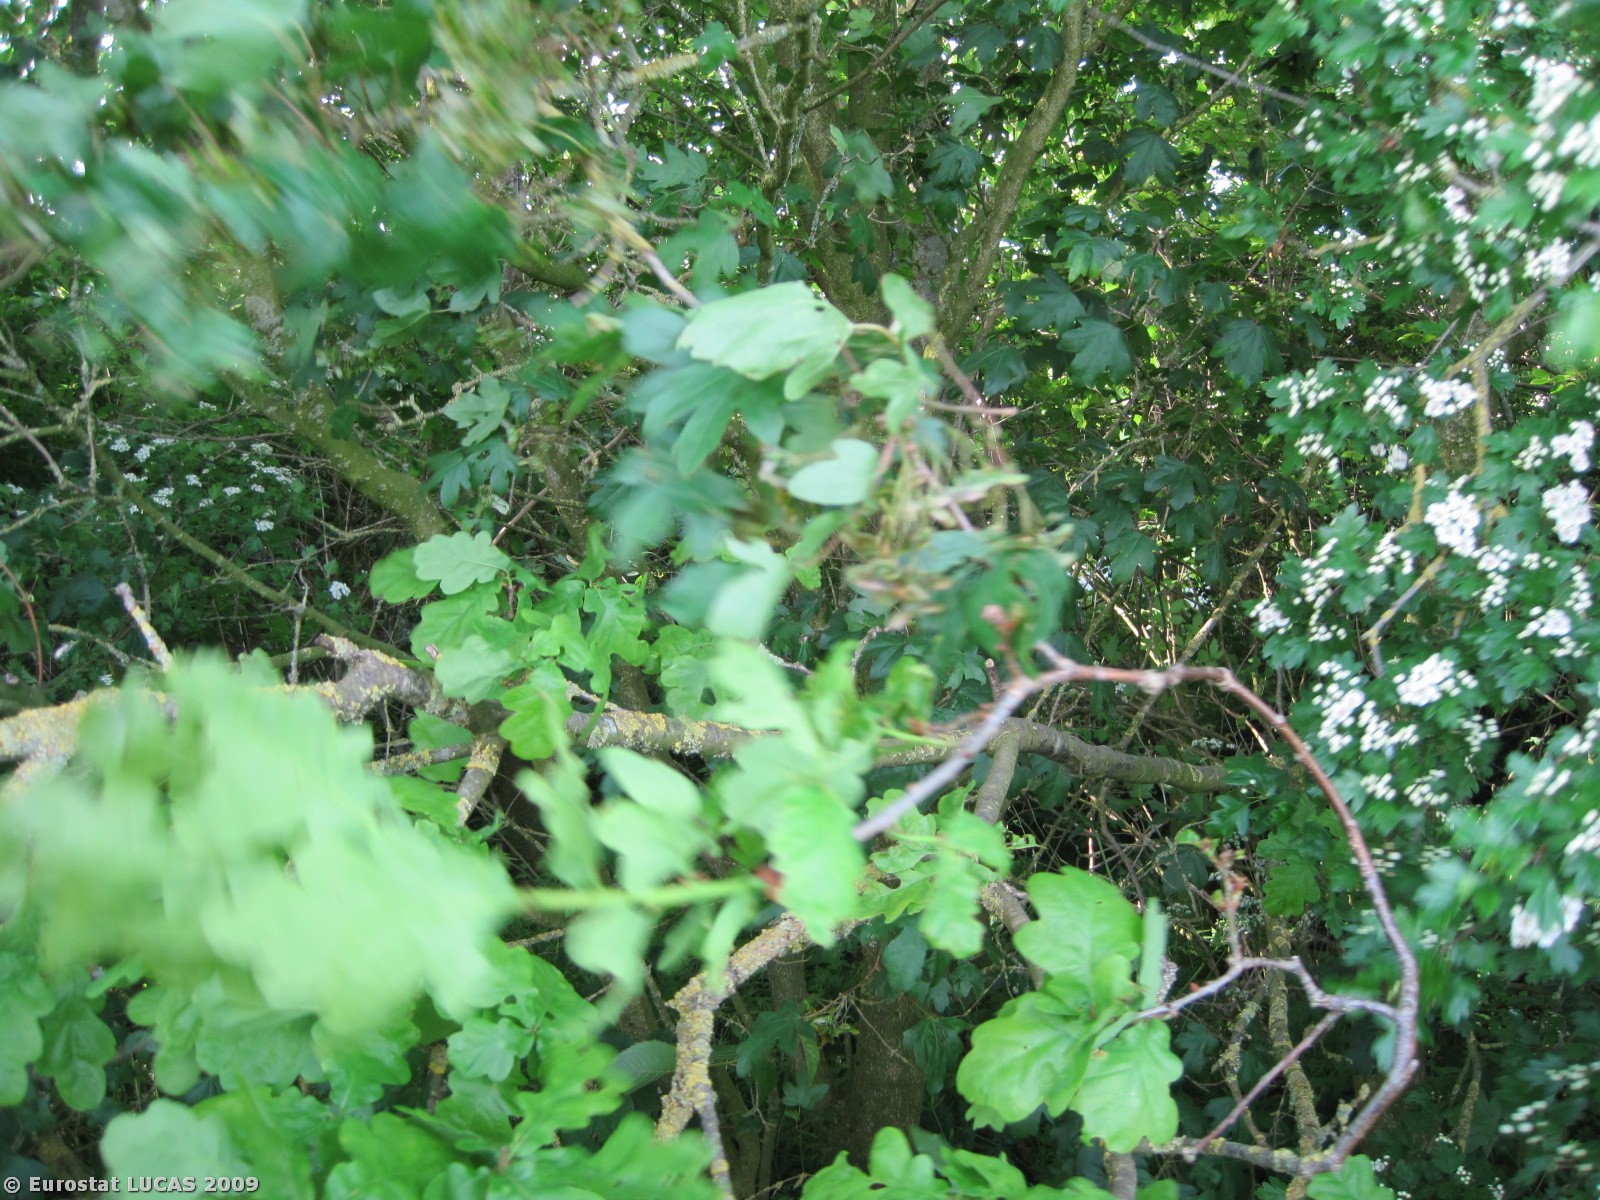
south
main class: Woodland
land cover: Broadleaved woodland
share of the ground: > 75 %
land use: Unused
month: May
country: DK
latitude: 56.5832
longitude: 10.0813
